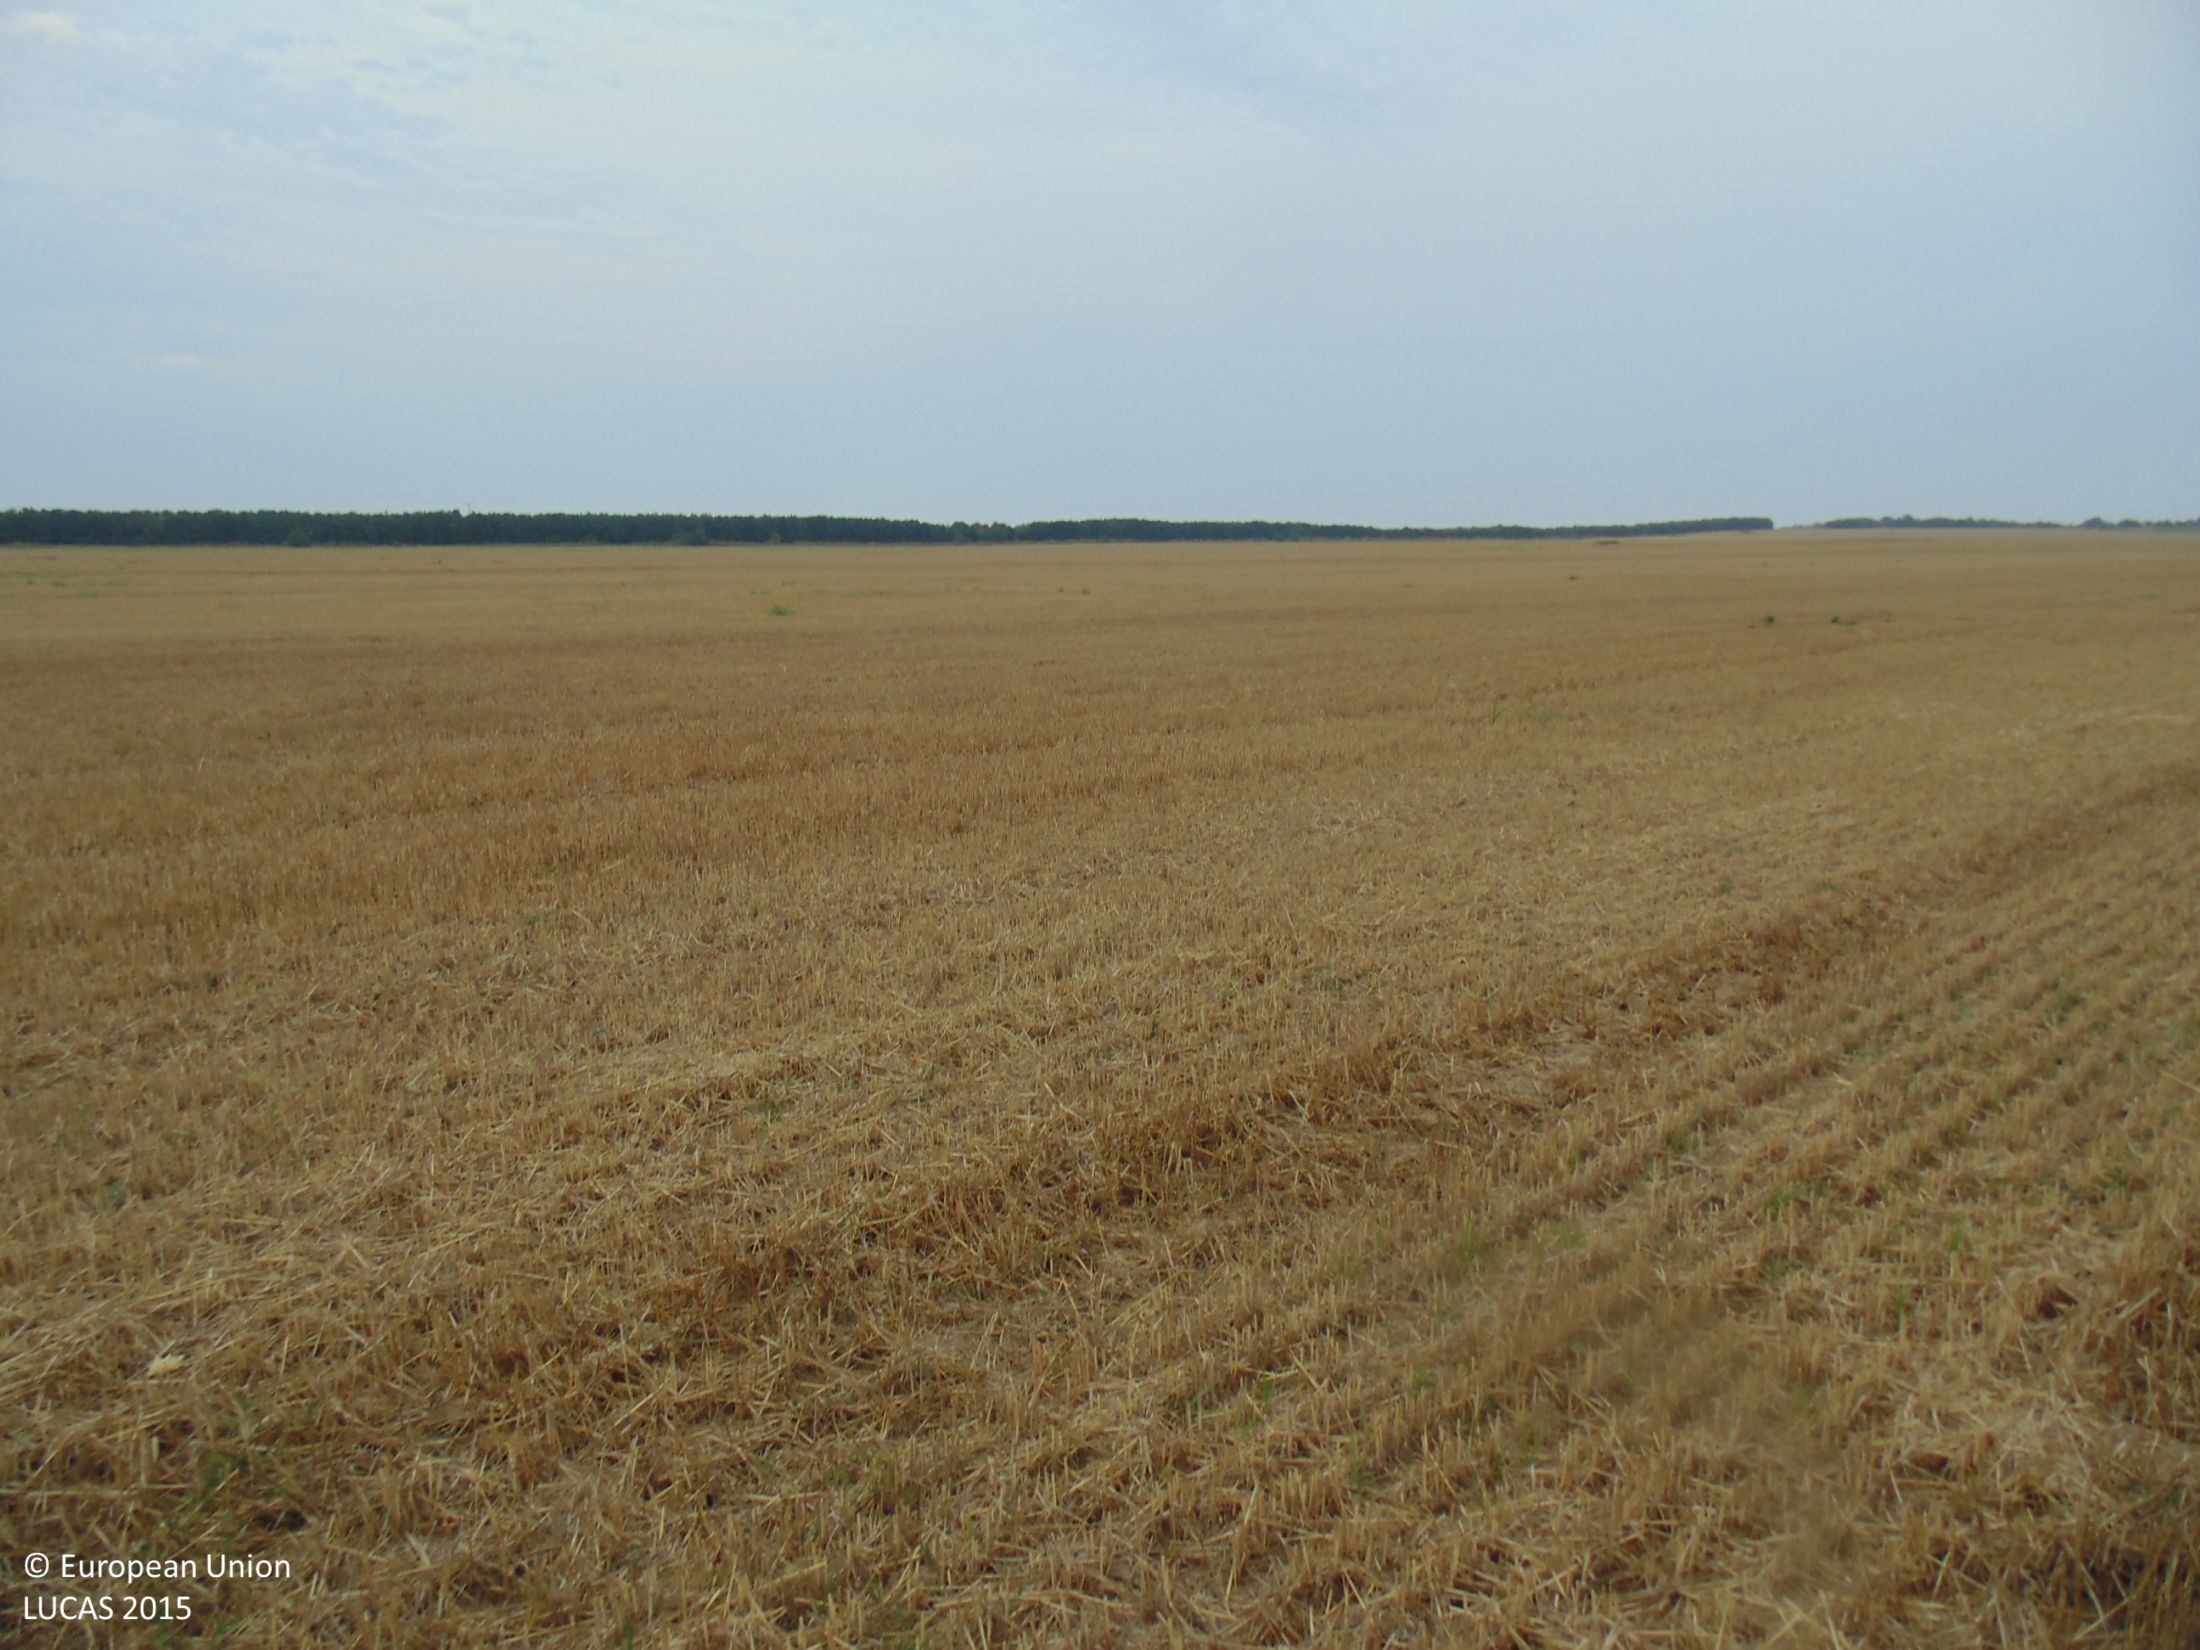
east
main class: Cropland
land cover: Common wheat
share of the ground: 50 - 75 %
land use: Agriculture (excluding fallow land and kitchen gardens)
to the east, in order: Common wheat
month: August
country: BG
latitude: 43.5084
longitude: 28.5559
